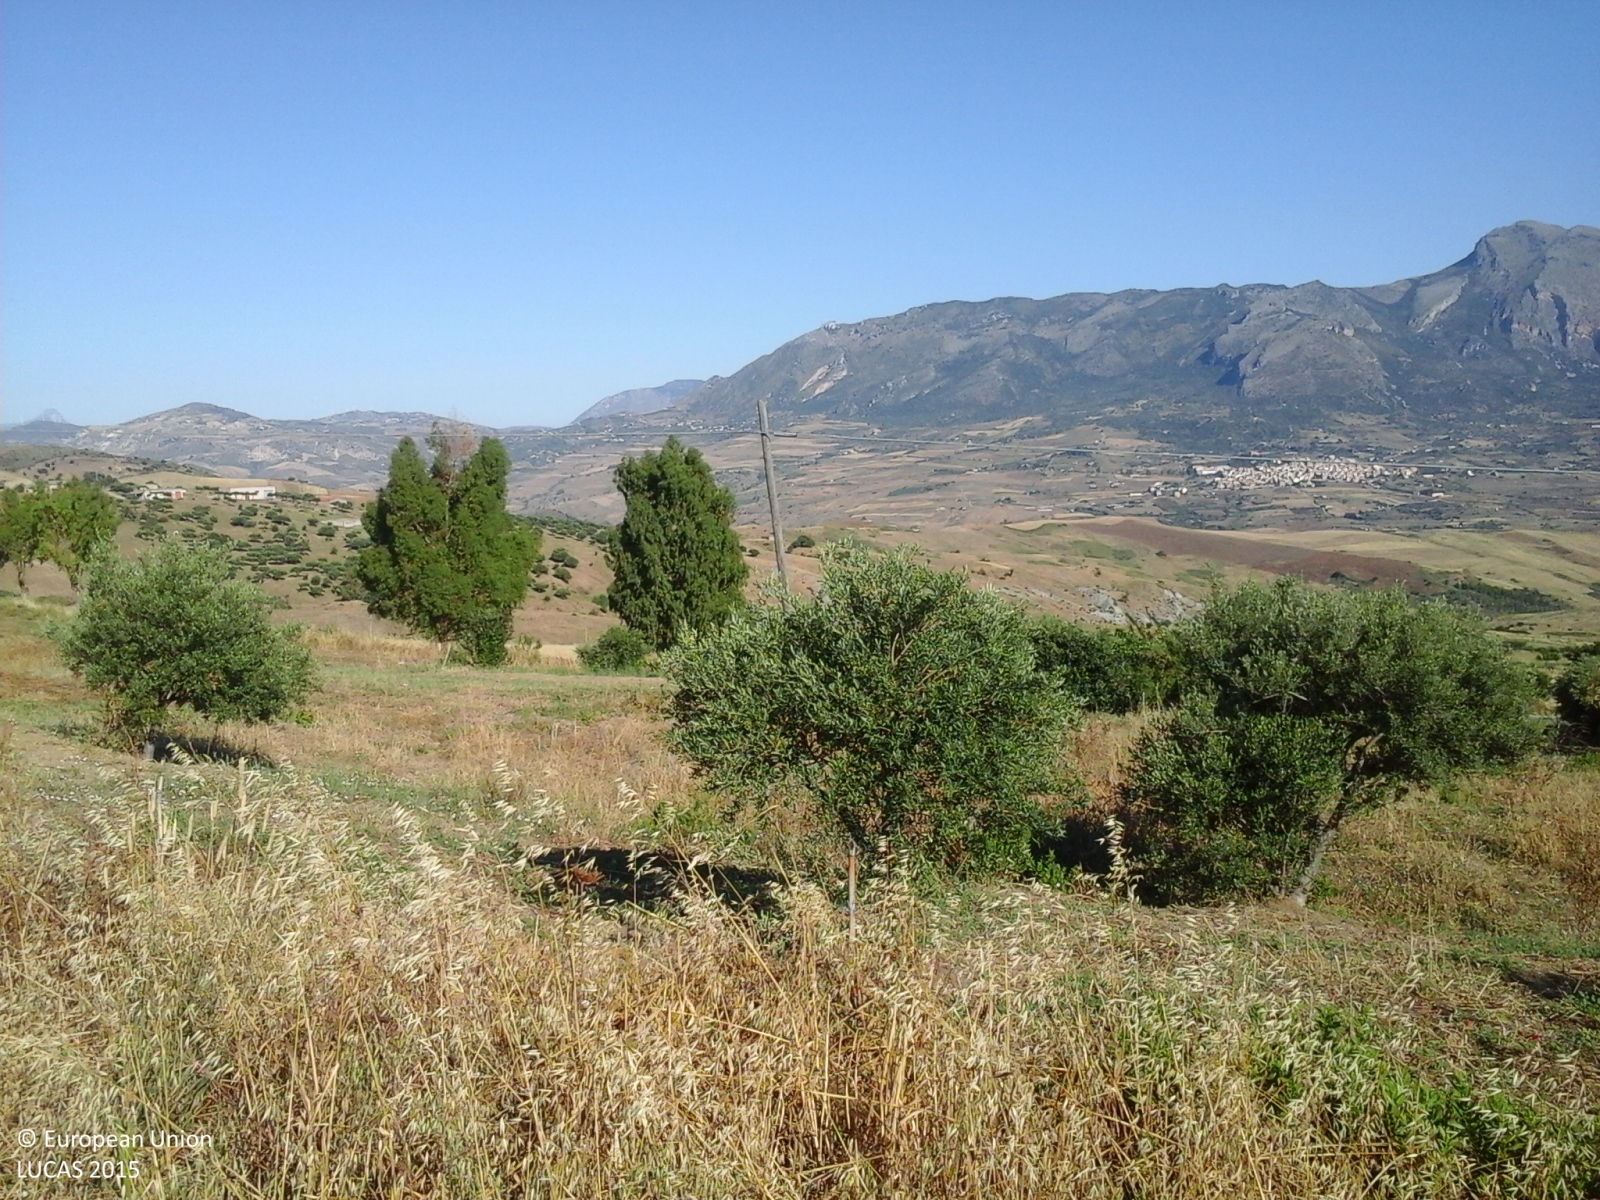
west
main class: Cropland
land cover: Olive groves
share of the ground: 25 - 50 %
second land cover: Spontaneously vegetated surfaces
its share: > 75 %
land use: Agriculture (excluding fallow land and kitchen gardens)
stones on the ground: < 10 %
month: June
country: IT
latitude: 37.8894
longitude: 13.8049
